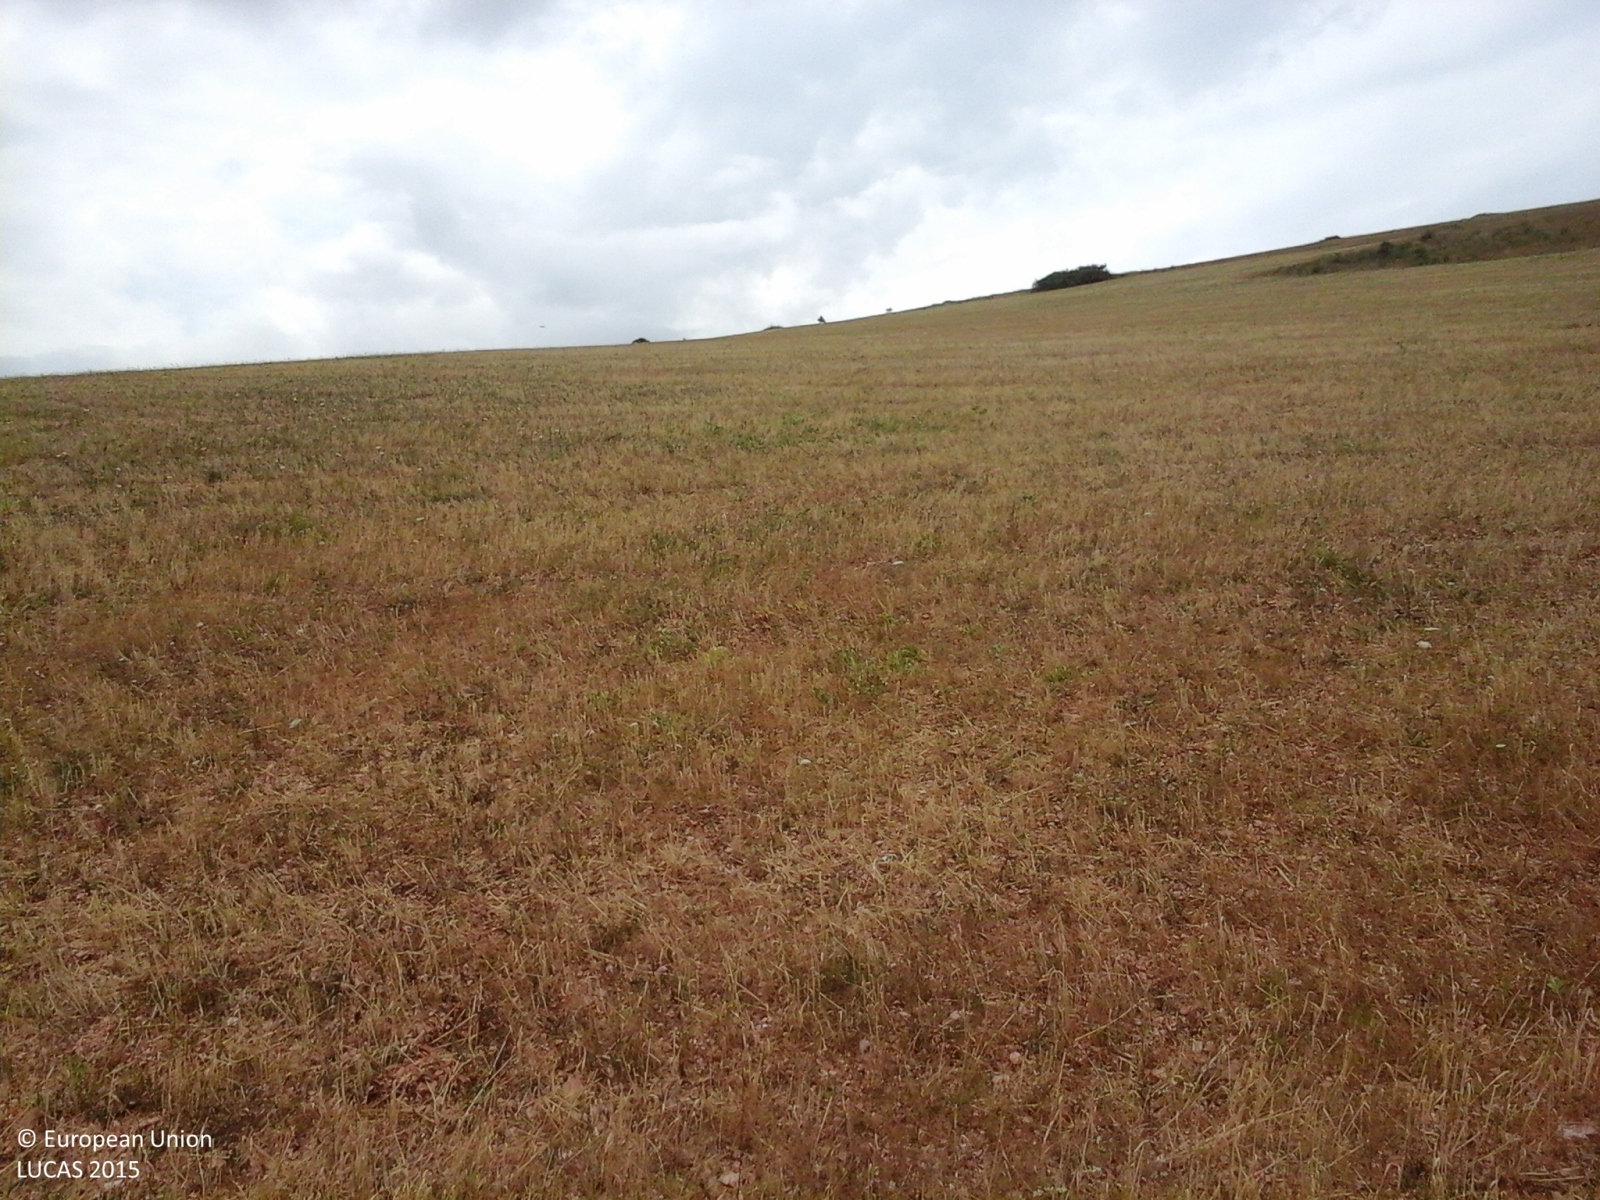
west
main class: Cropland
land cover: Triticale
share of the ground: > 75 %
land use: Agriculture (excluding fallow land and kitchen gardens)
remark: Harvested field
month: July
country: IT
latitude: 43.2380
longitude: 13.1318
